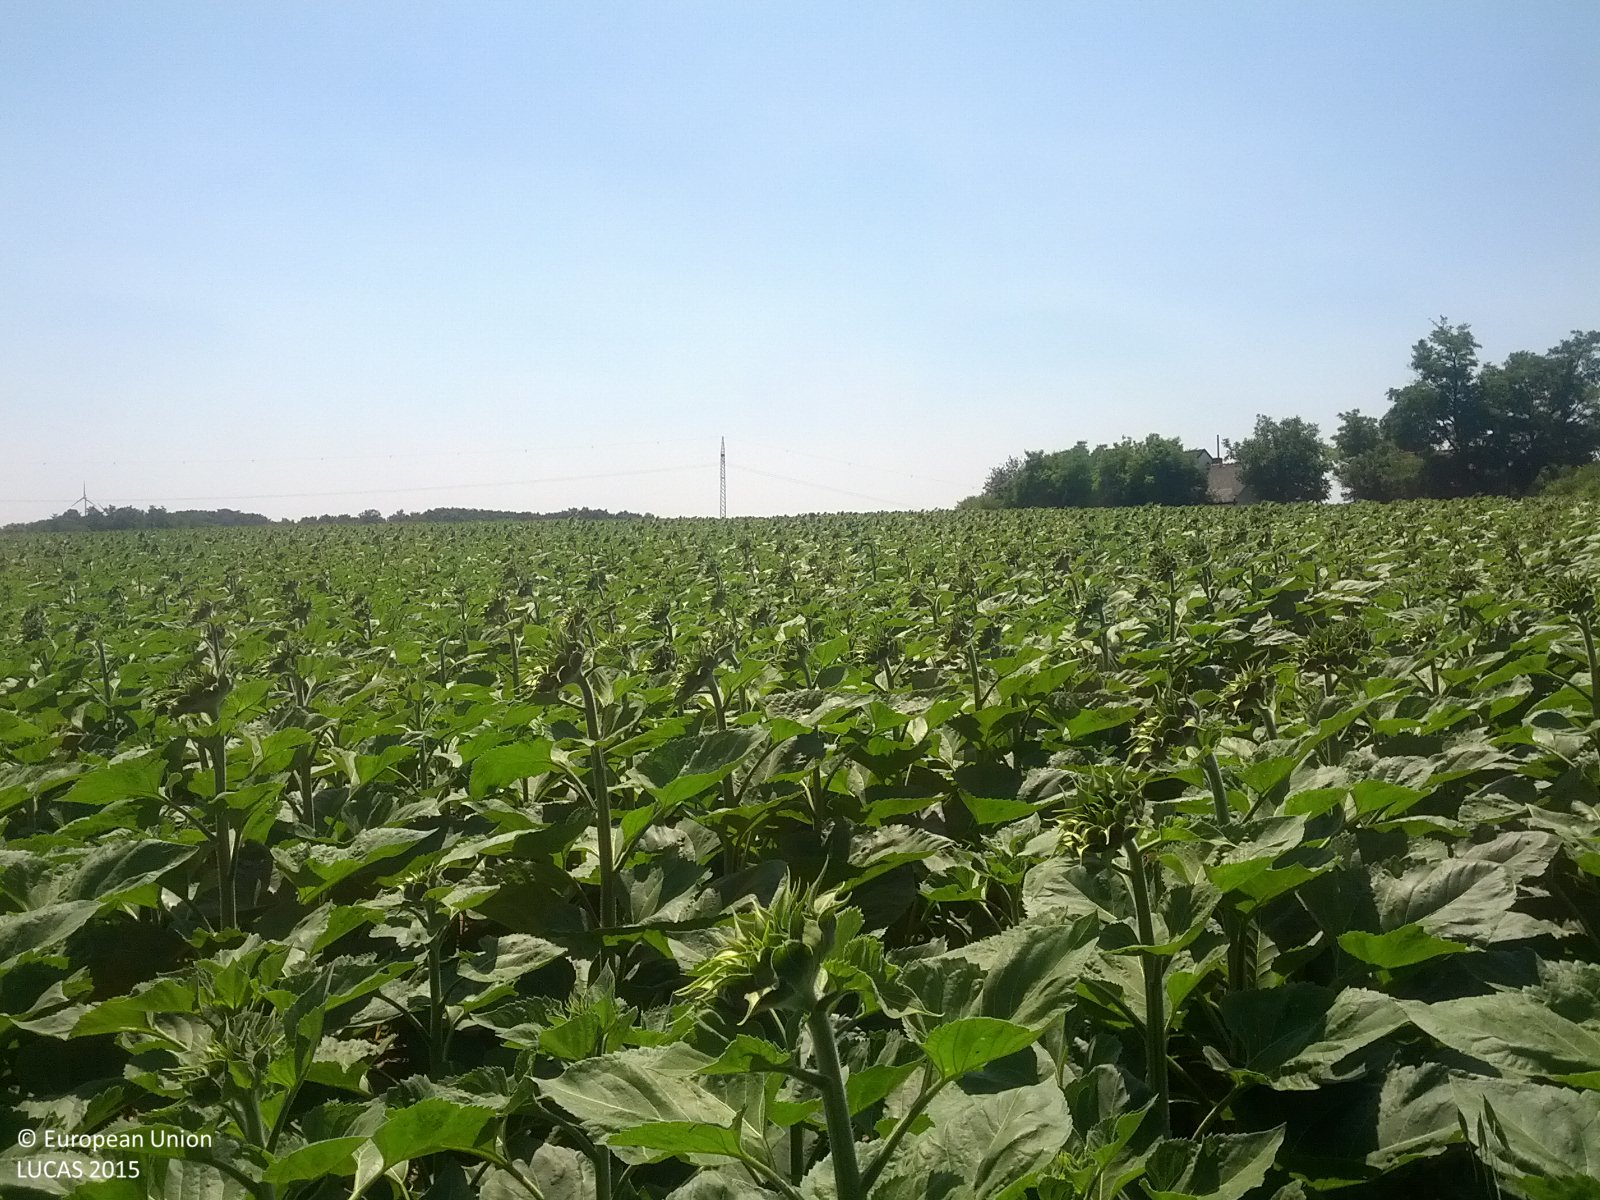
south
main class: Cropland
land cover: Sunflower
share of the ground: > 75 %
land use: Agriculture (excluding fallow land and kitchen gardens)
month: July
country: AT
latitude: 48.5506
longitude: 16.5768
